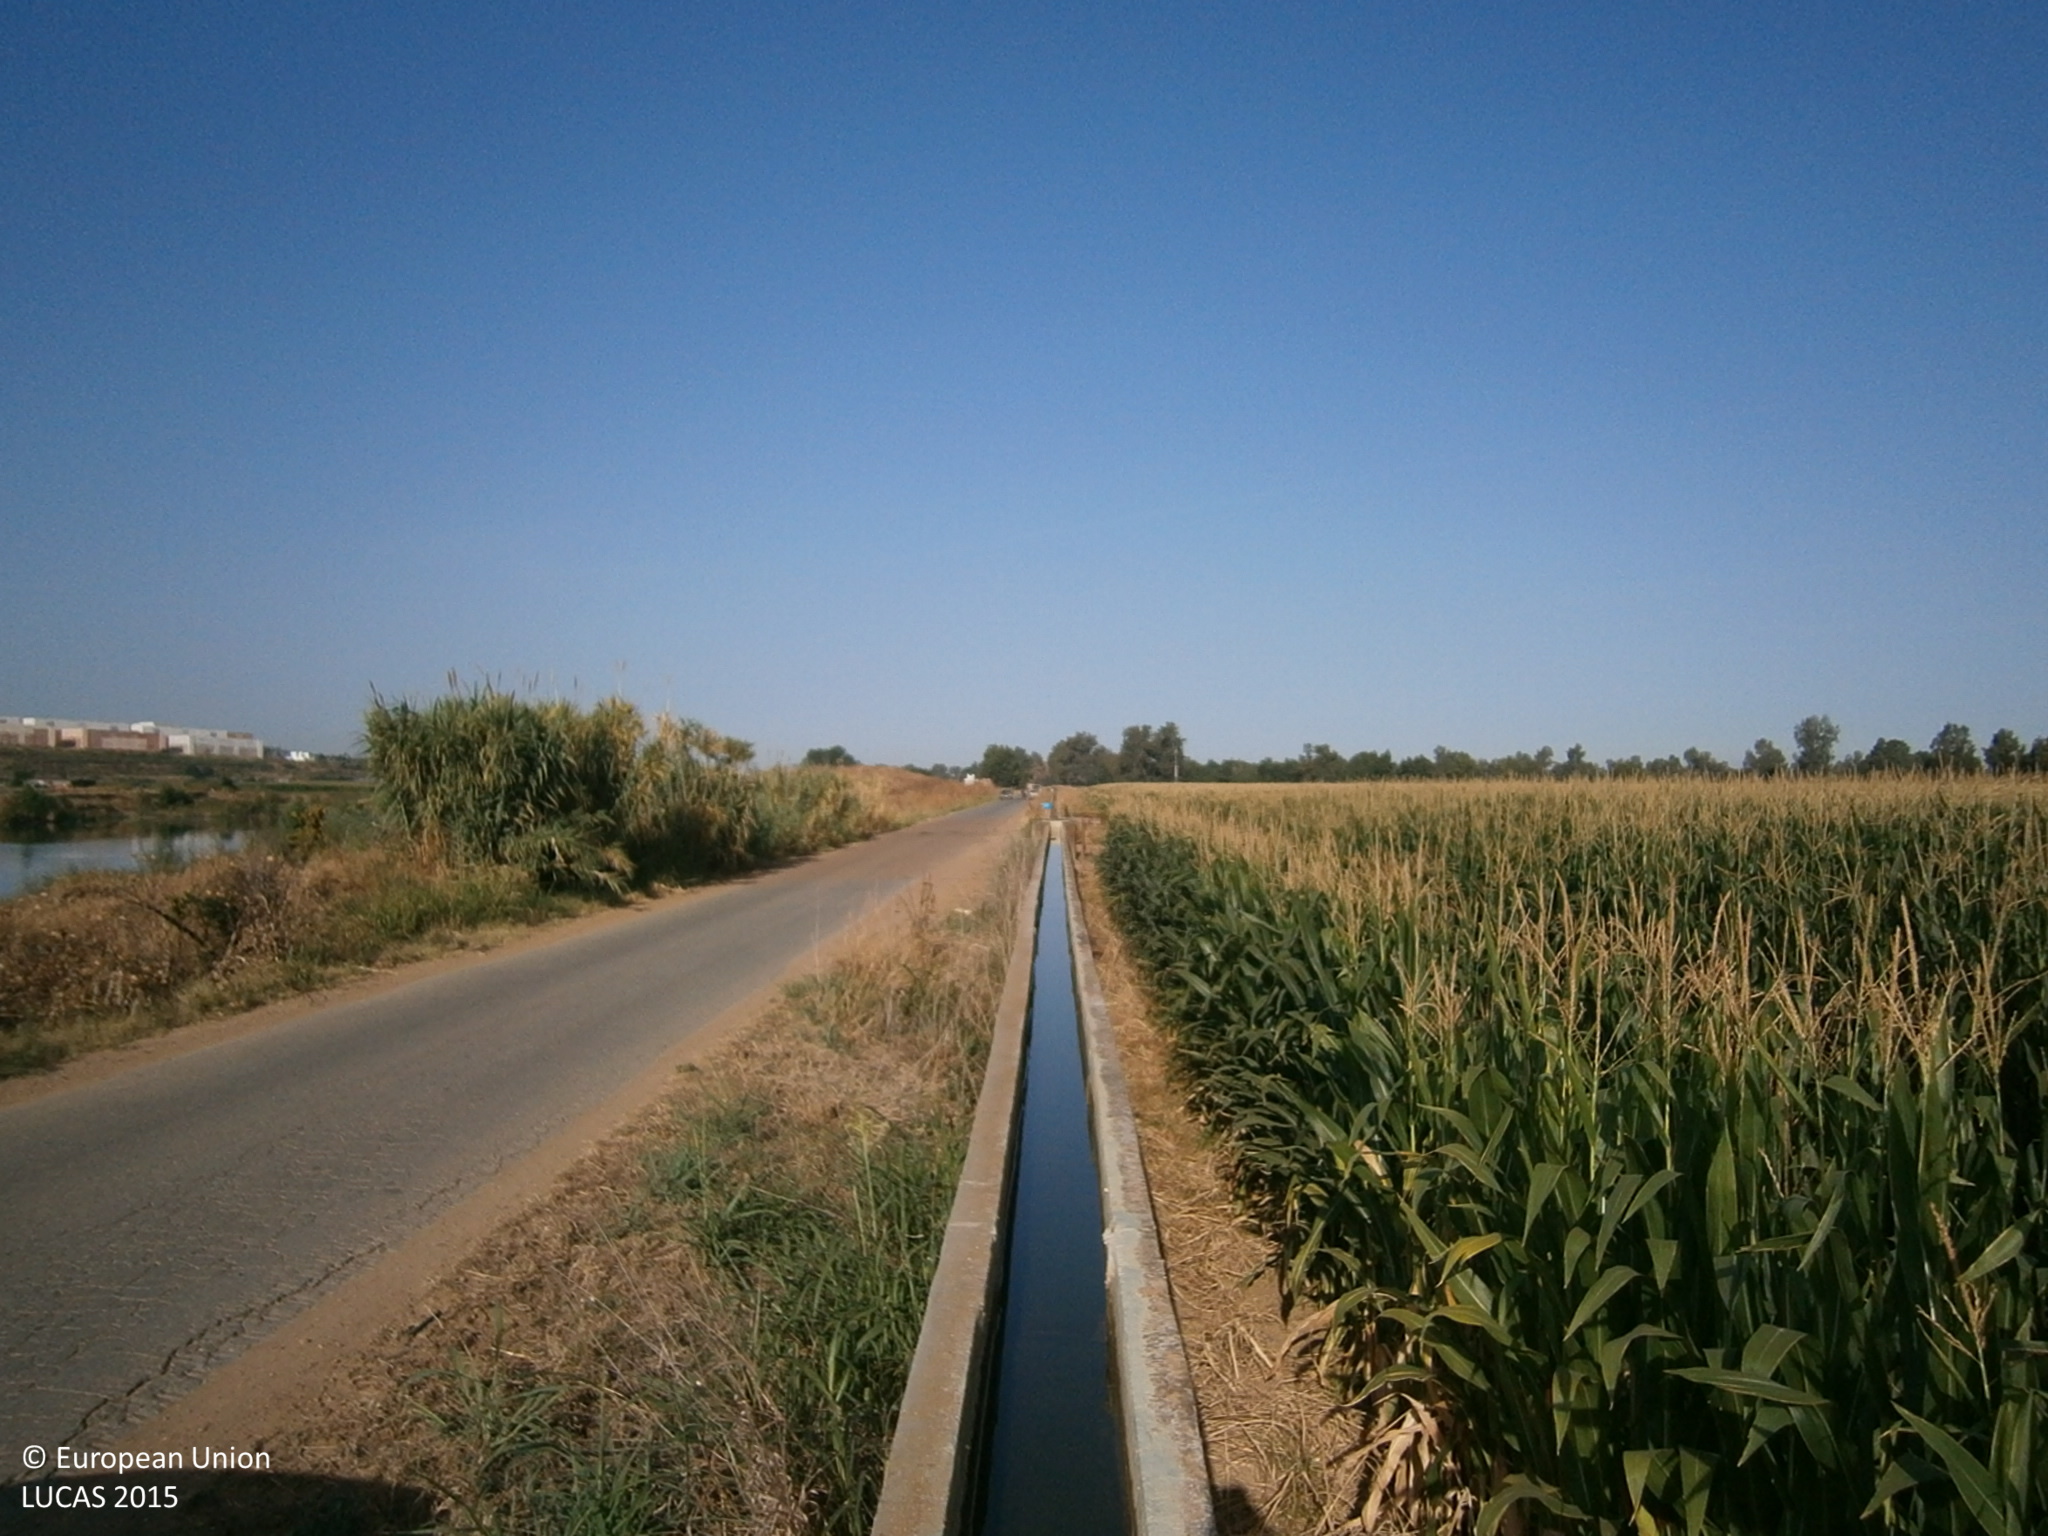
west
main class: Cropland
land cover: Maize
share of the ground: > 75 %
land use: Agriculture (excluding fallow land and kitchen gardens)
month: July
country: ES
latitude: 38.9013
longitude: -6.8918
